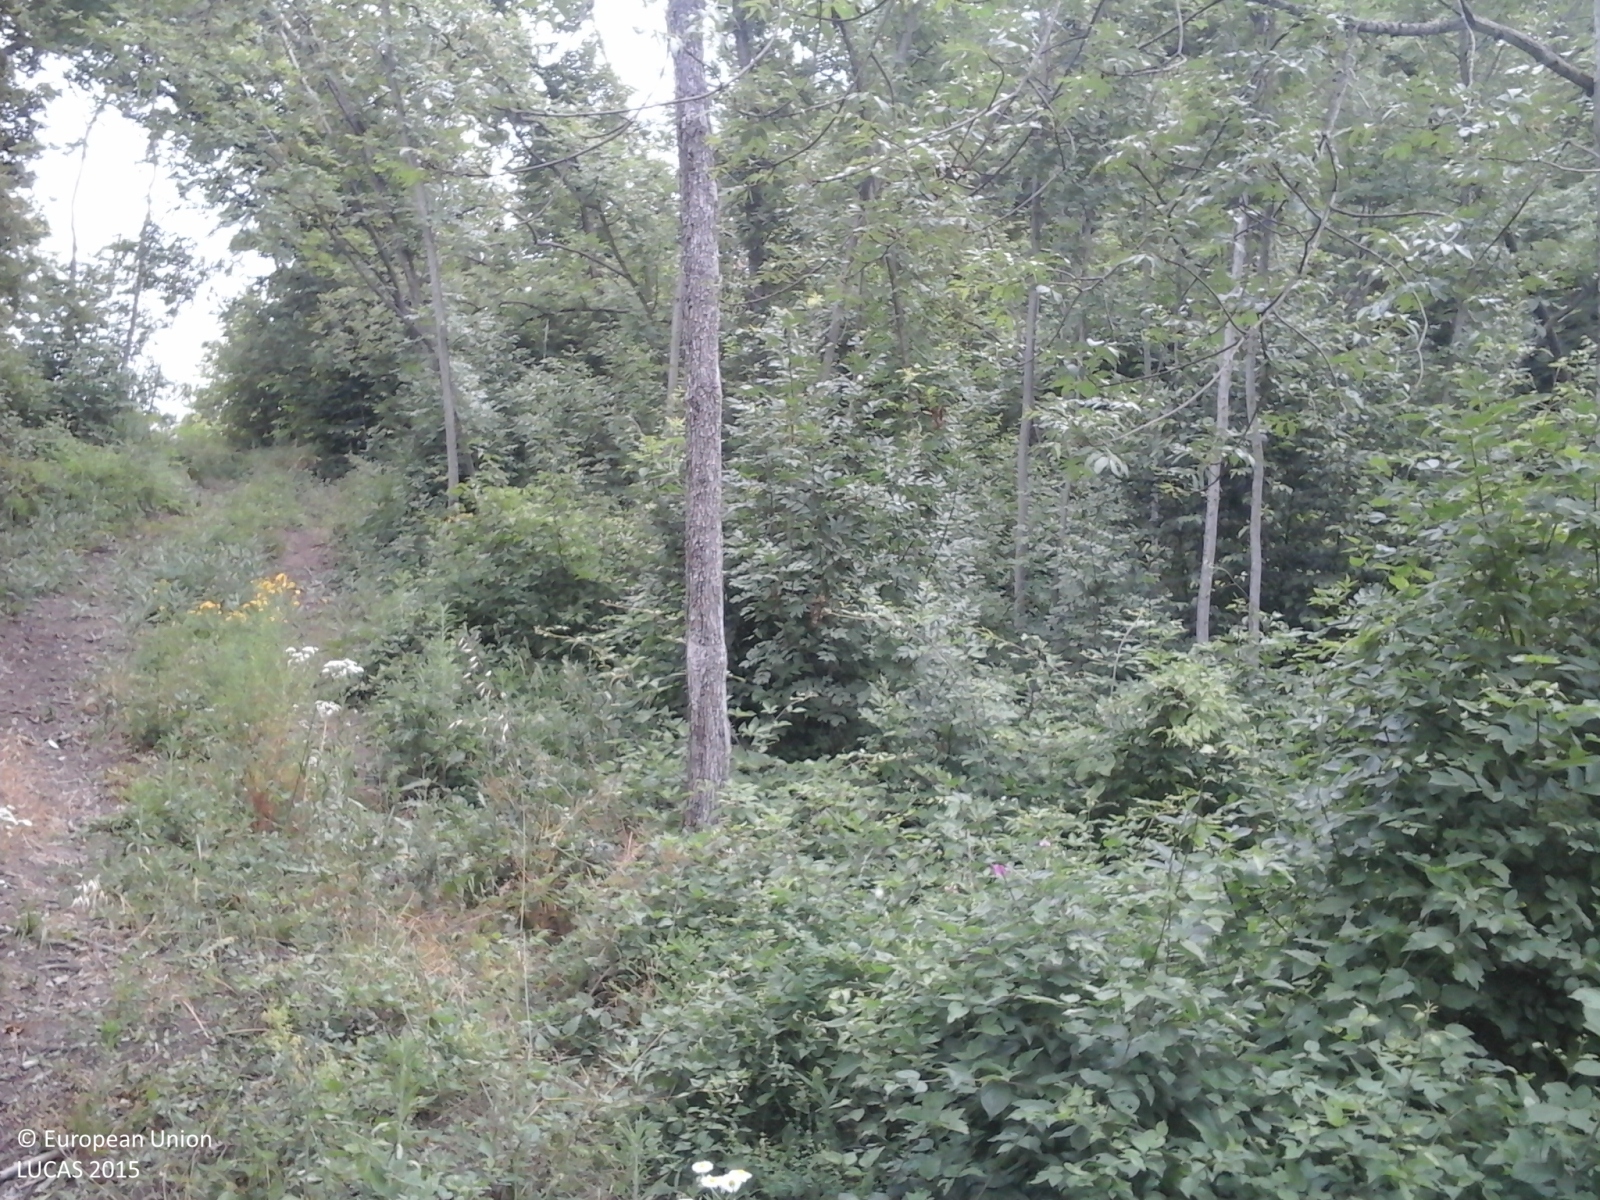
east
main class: Woodland
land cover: Broadleaved woodland
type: thermophilous deciduous forest
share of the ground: > 75 %
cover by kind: broadleaved forest trees 100 %
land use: Forestry
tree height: > 5 m
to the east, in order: Broadleaved woodland; Grassland without tree/shrub cover
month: June
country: IT
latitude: 44.5667
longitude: 10.2387
